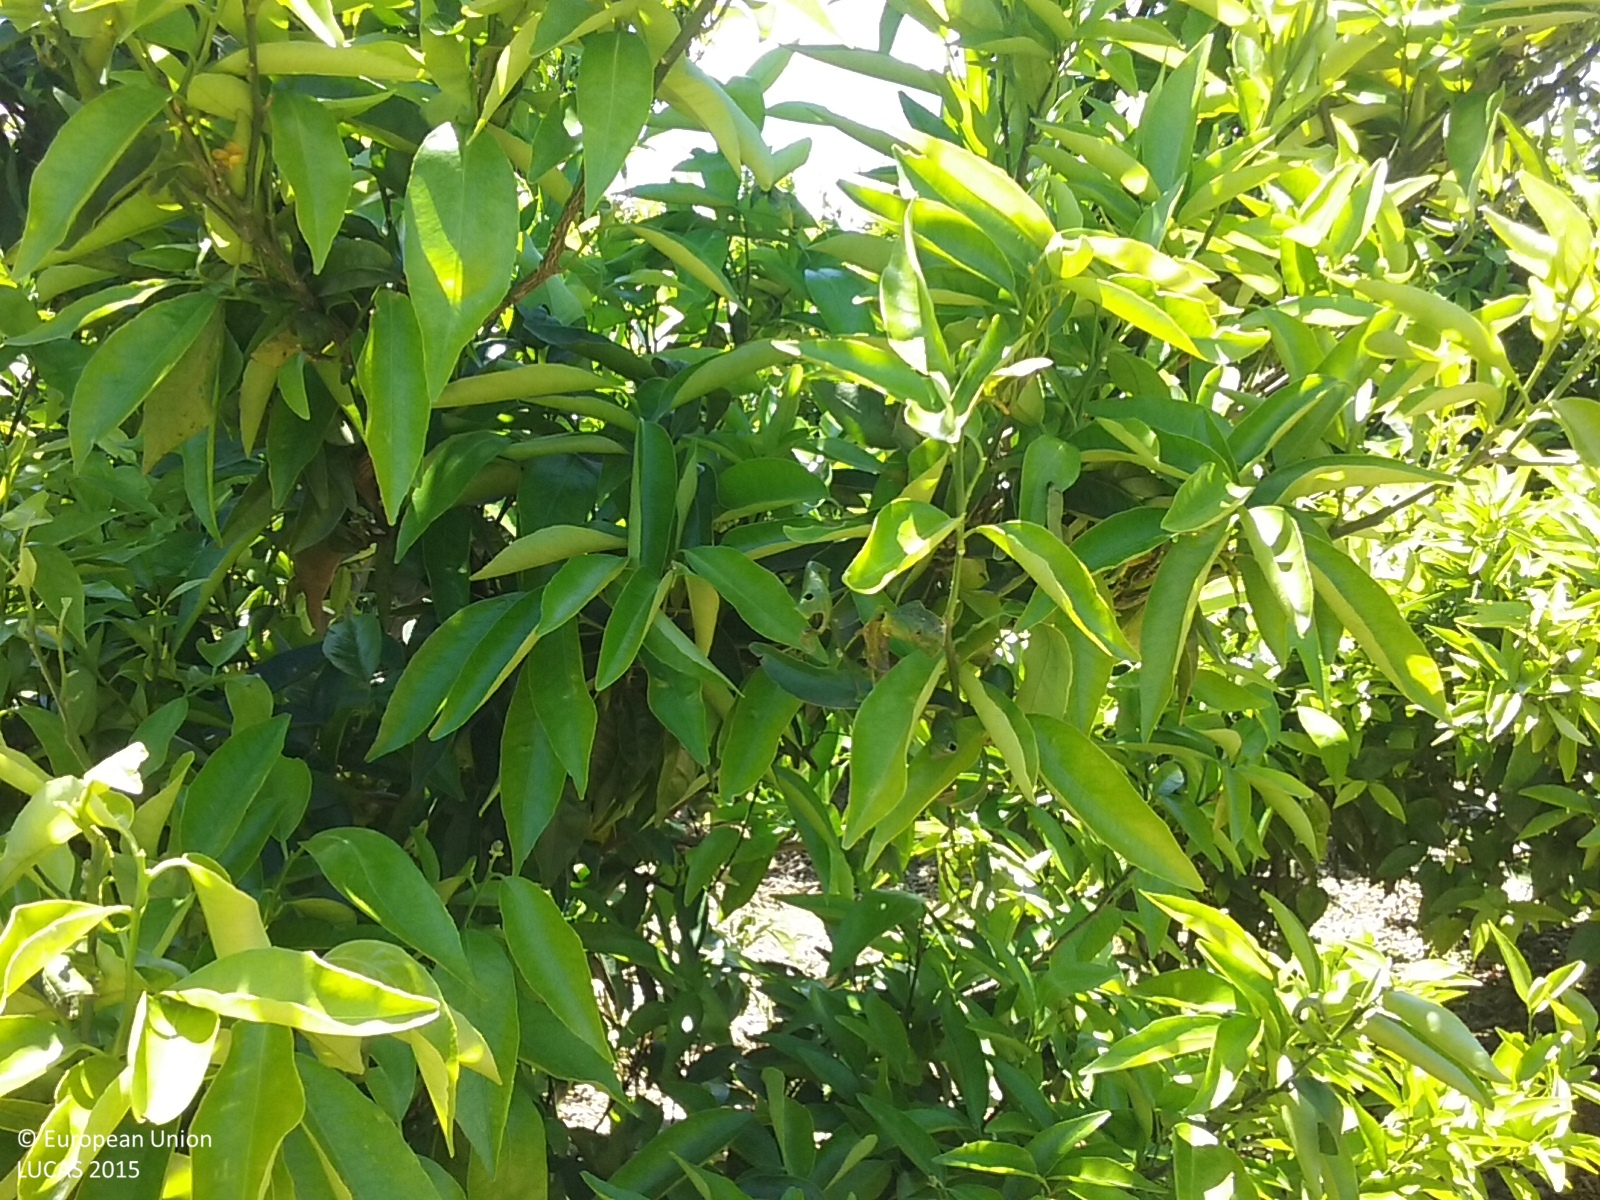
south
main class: Cropland
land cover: Oranges
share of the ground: 50 - 75 %
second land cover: Other bare soil
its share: > 75 %
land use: Agriculture (excluding fallow land and kitchen gardens)
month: May
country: ES
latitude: 40.7278
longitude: 0.4394
